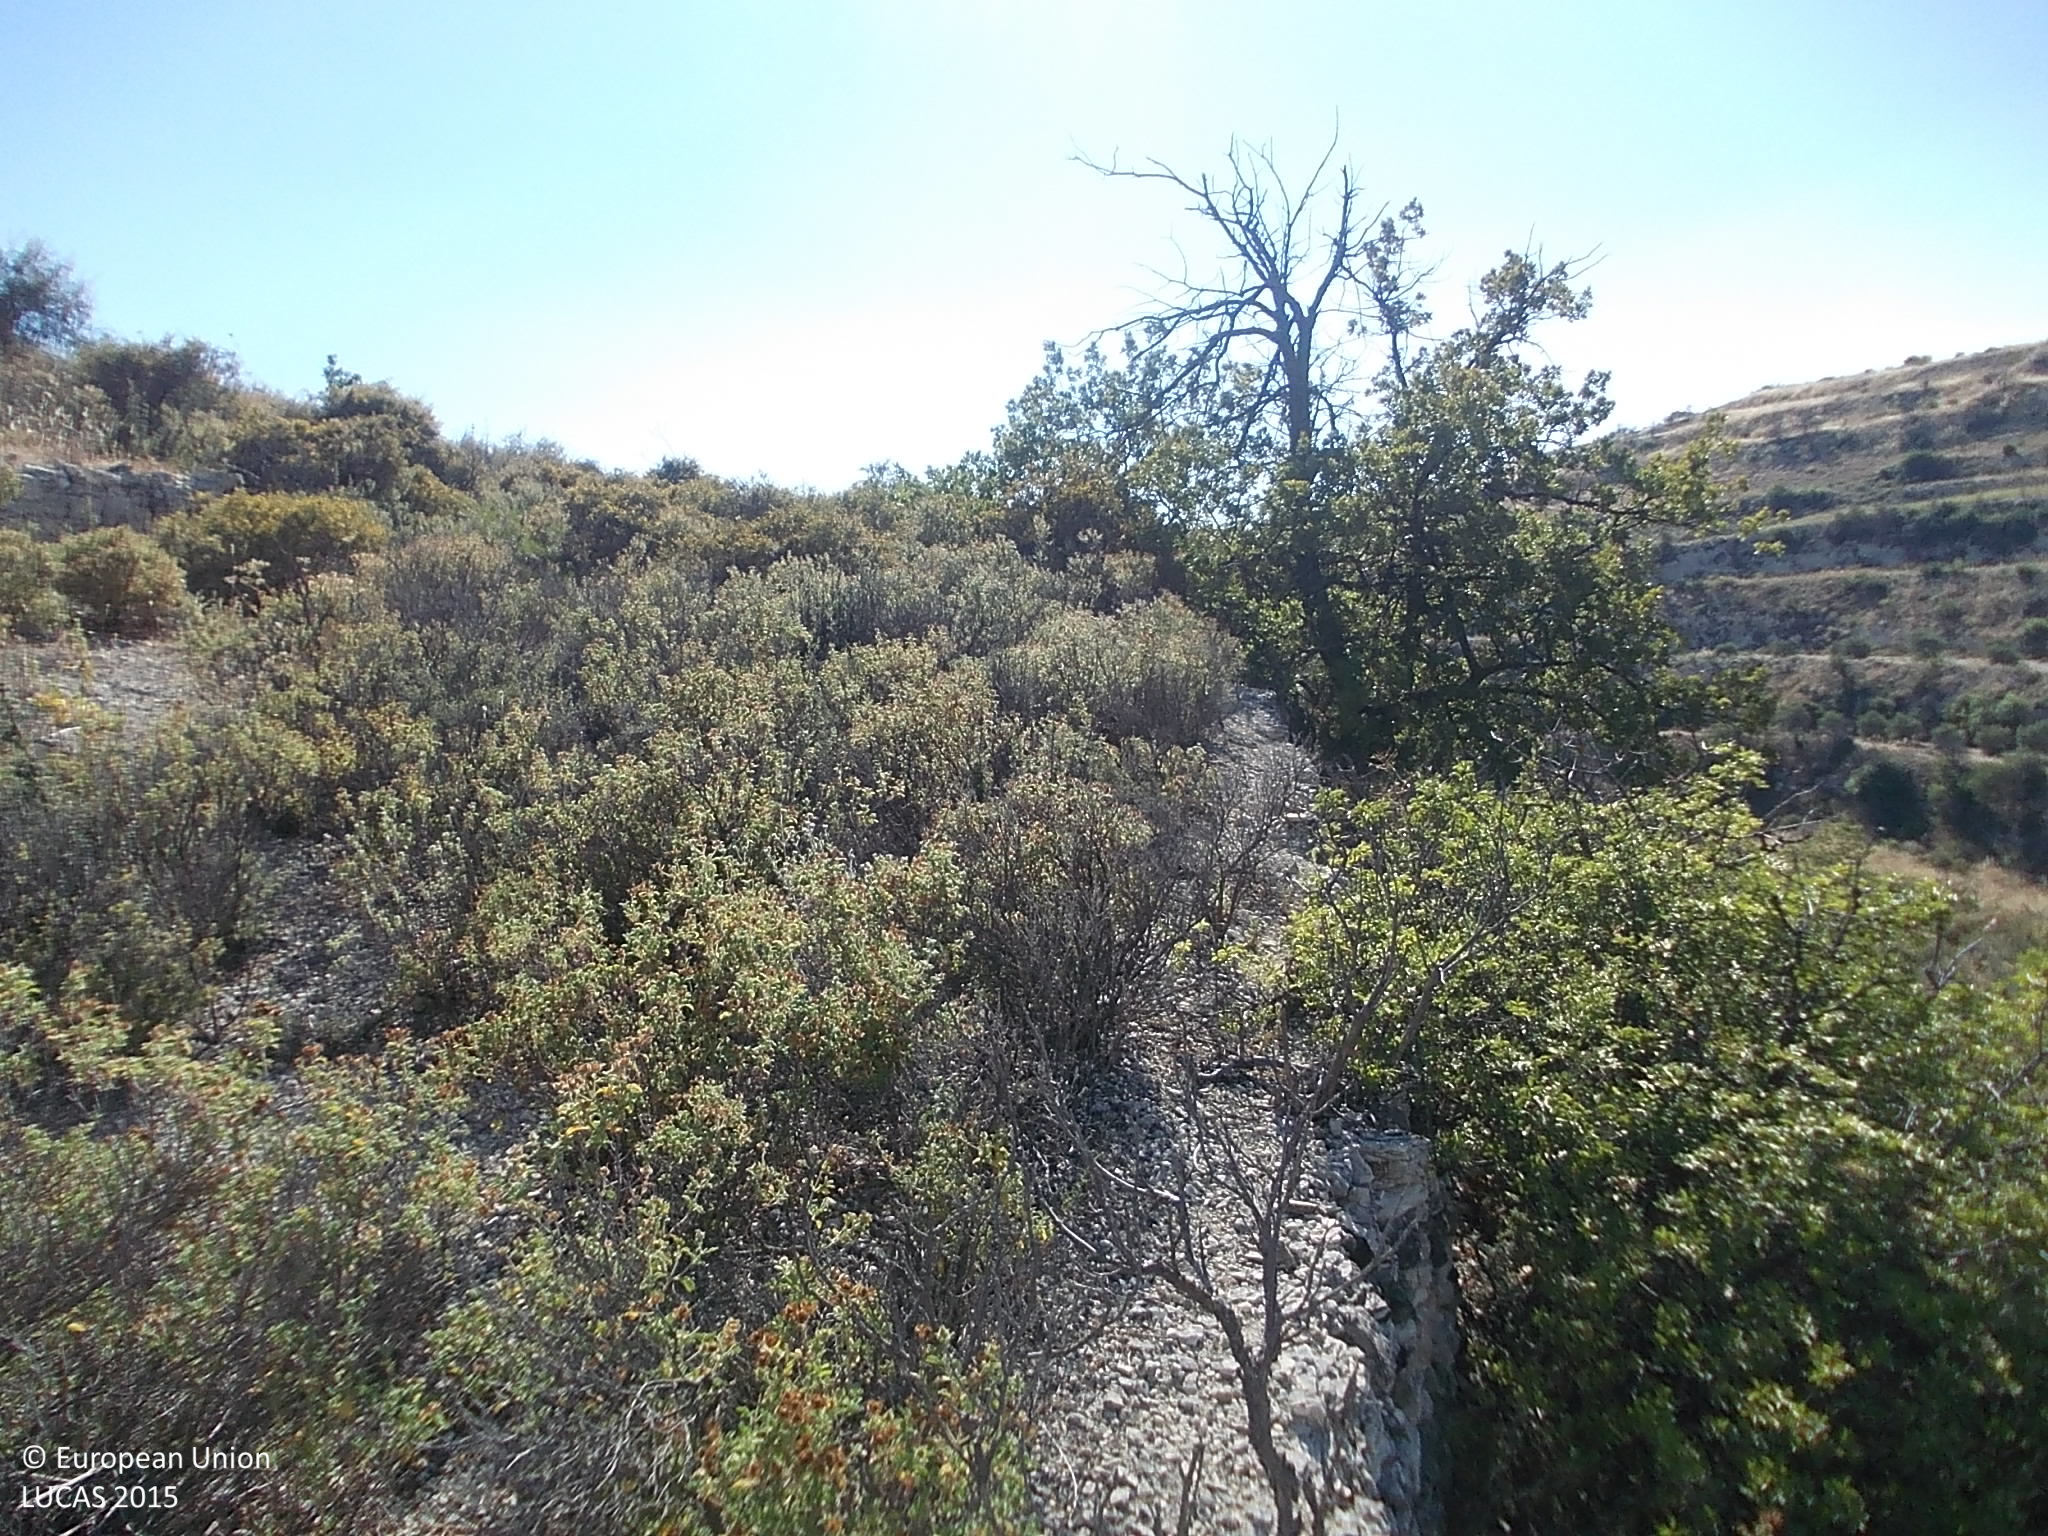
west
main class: Shrubland
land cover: Shrubland with sparse tree cover
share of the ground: 50 - 75 %
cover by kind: shrubs 55 %, herbaceous plants 25 %, unconsolidated bare surface 15 %, coniferous forest trees 5 %
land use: Semi-natural and natural areas not in use
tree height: < 5 m
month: July
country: CY
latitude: 34.8198
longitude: 32.8249
